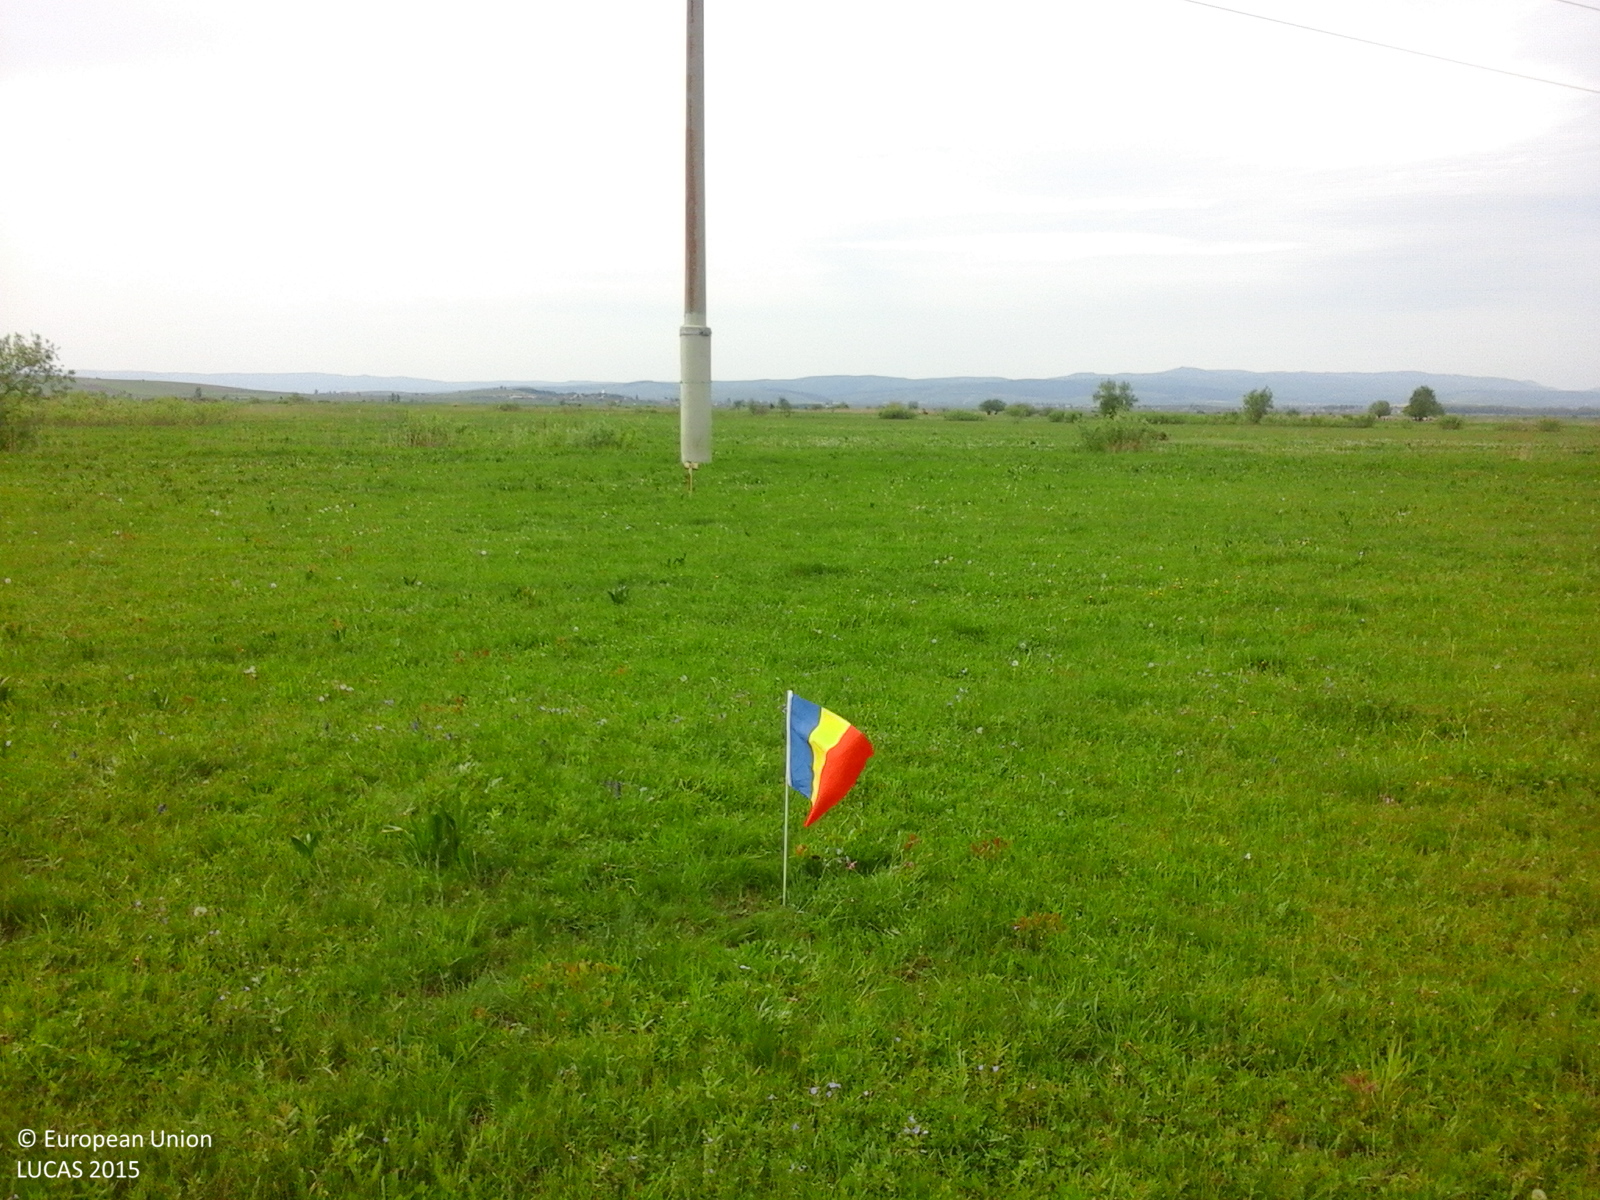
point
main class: Grassland
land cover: Grassland without tree/shrub cover
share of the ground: > 75 %
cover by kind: herbaceous plants 100 %
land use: Agriculture (excluding fallow land and kitchen gardens)
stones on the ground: < 10 %
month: May
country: RO
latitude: 45.7890
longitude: 26.0547
